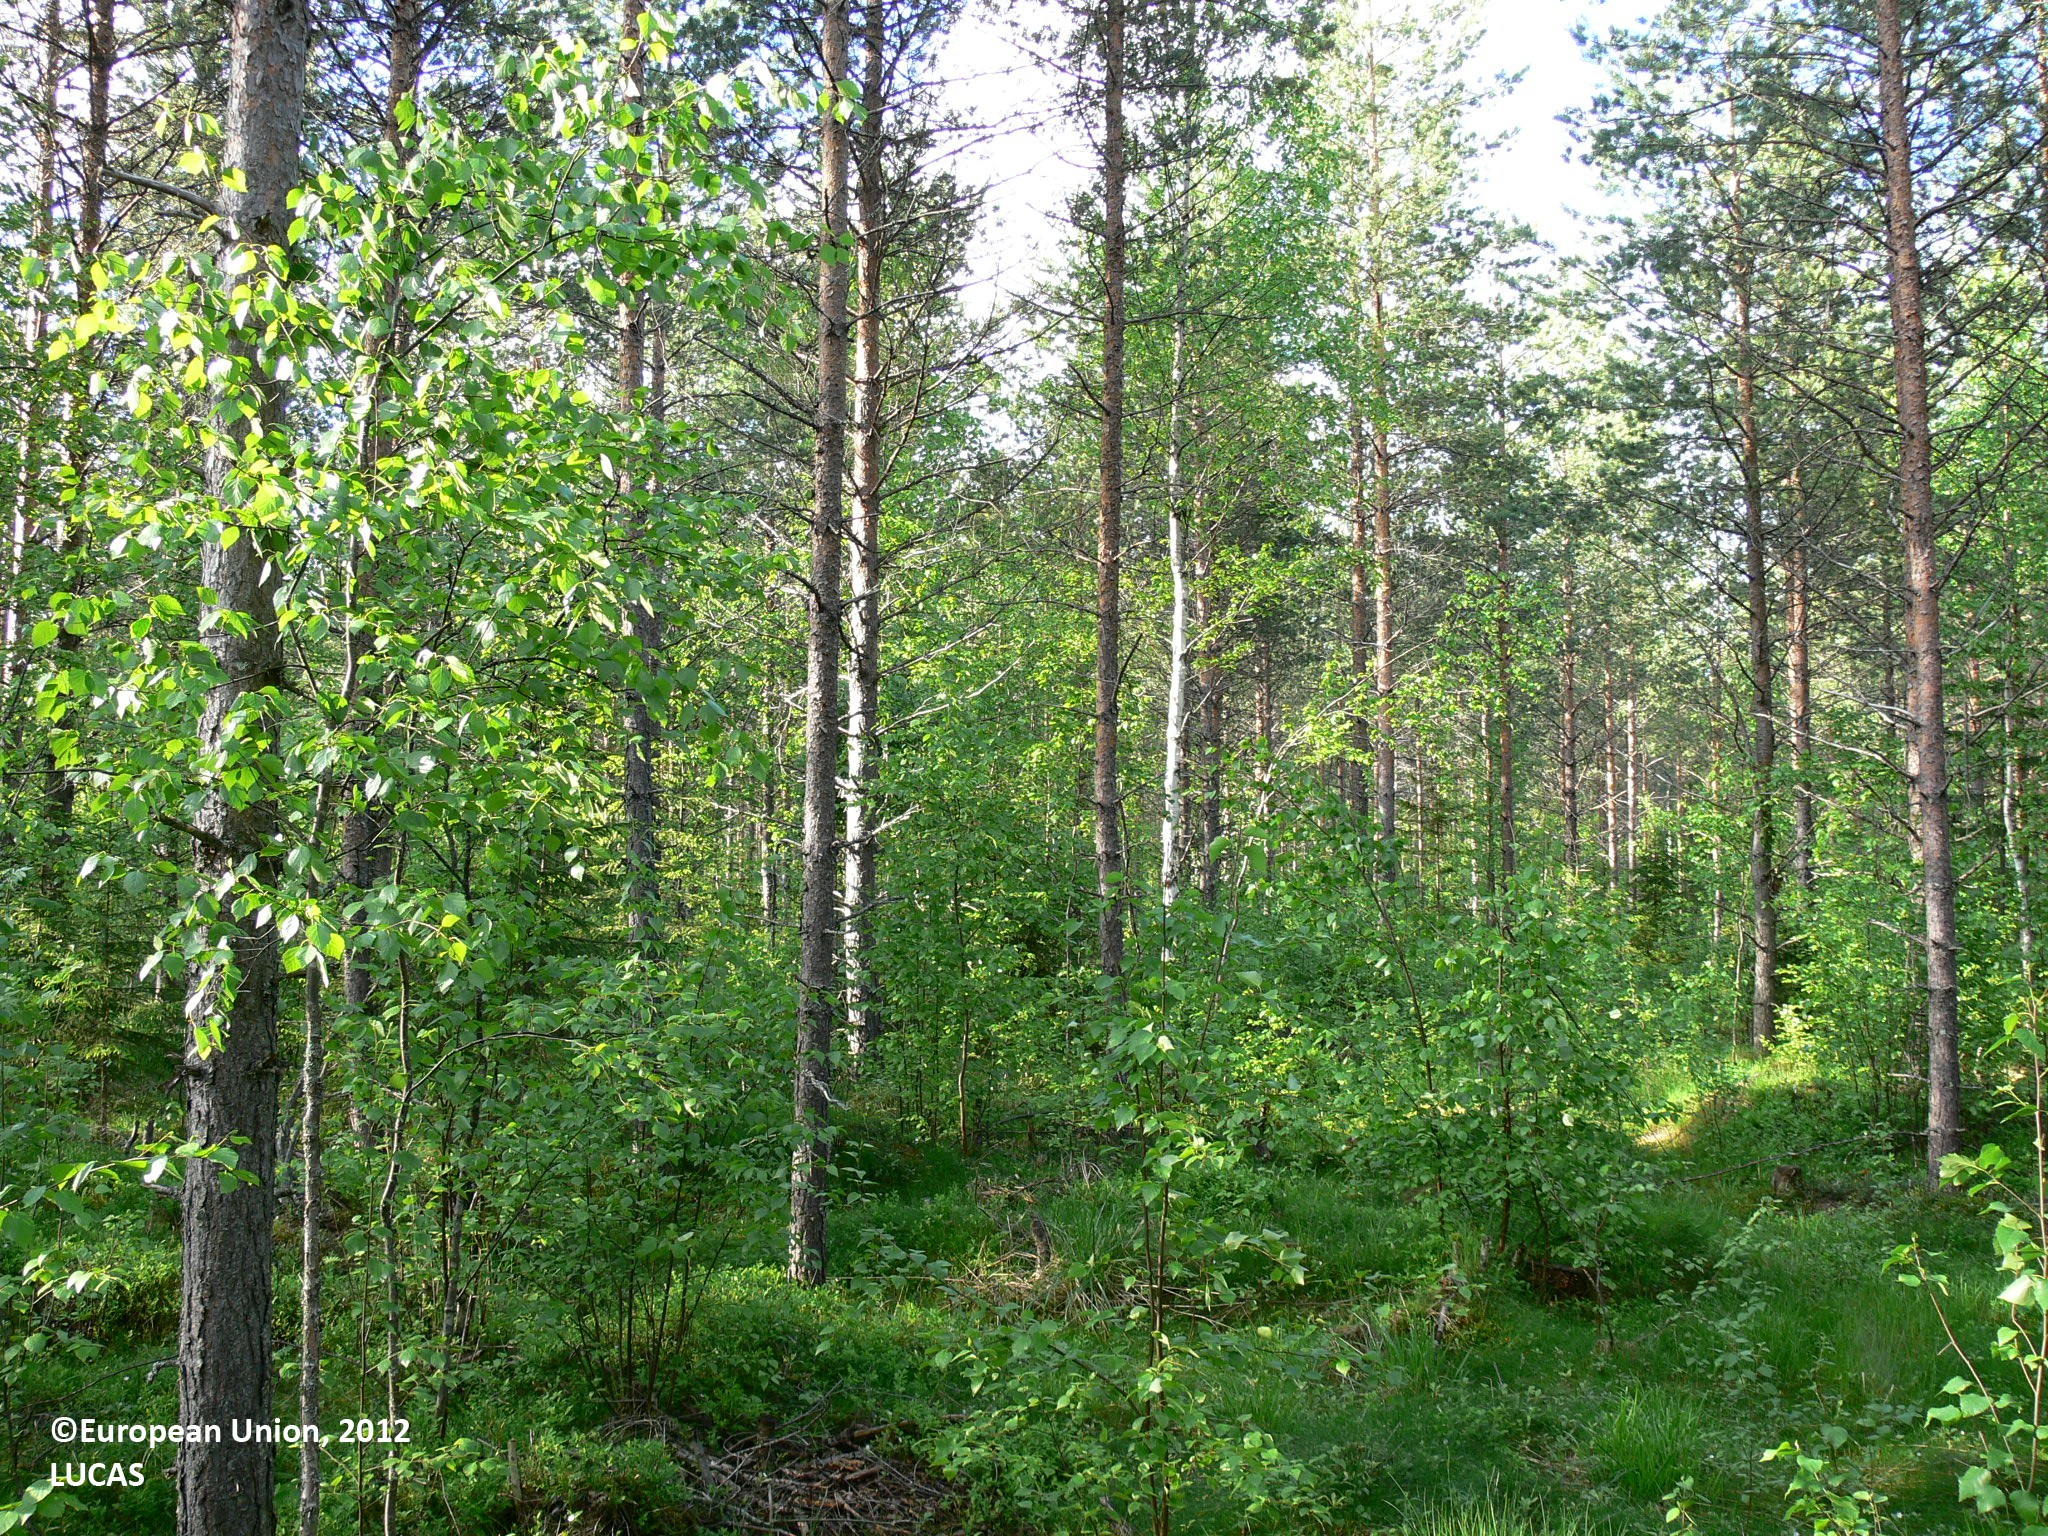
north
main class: Woodland
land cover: Pine dominated coniferous woodland
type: boreal forest
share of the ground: 50 - 75 %
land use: Forestry
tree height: > 5 m
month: June
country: FI
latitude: 62.3742
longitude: 30.2416
